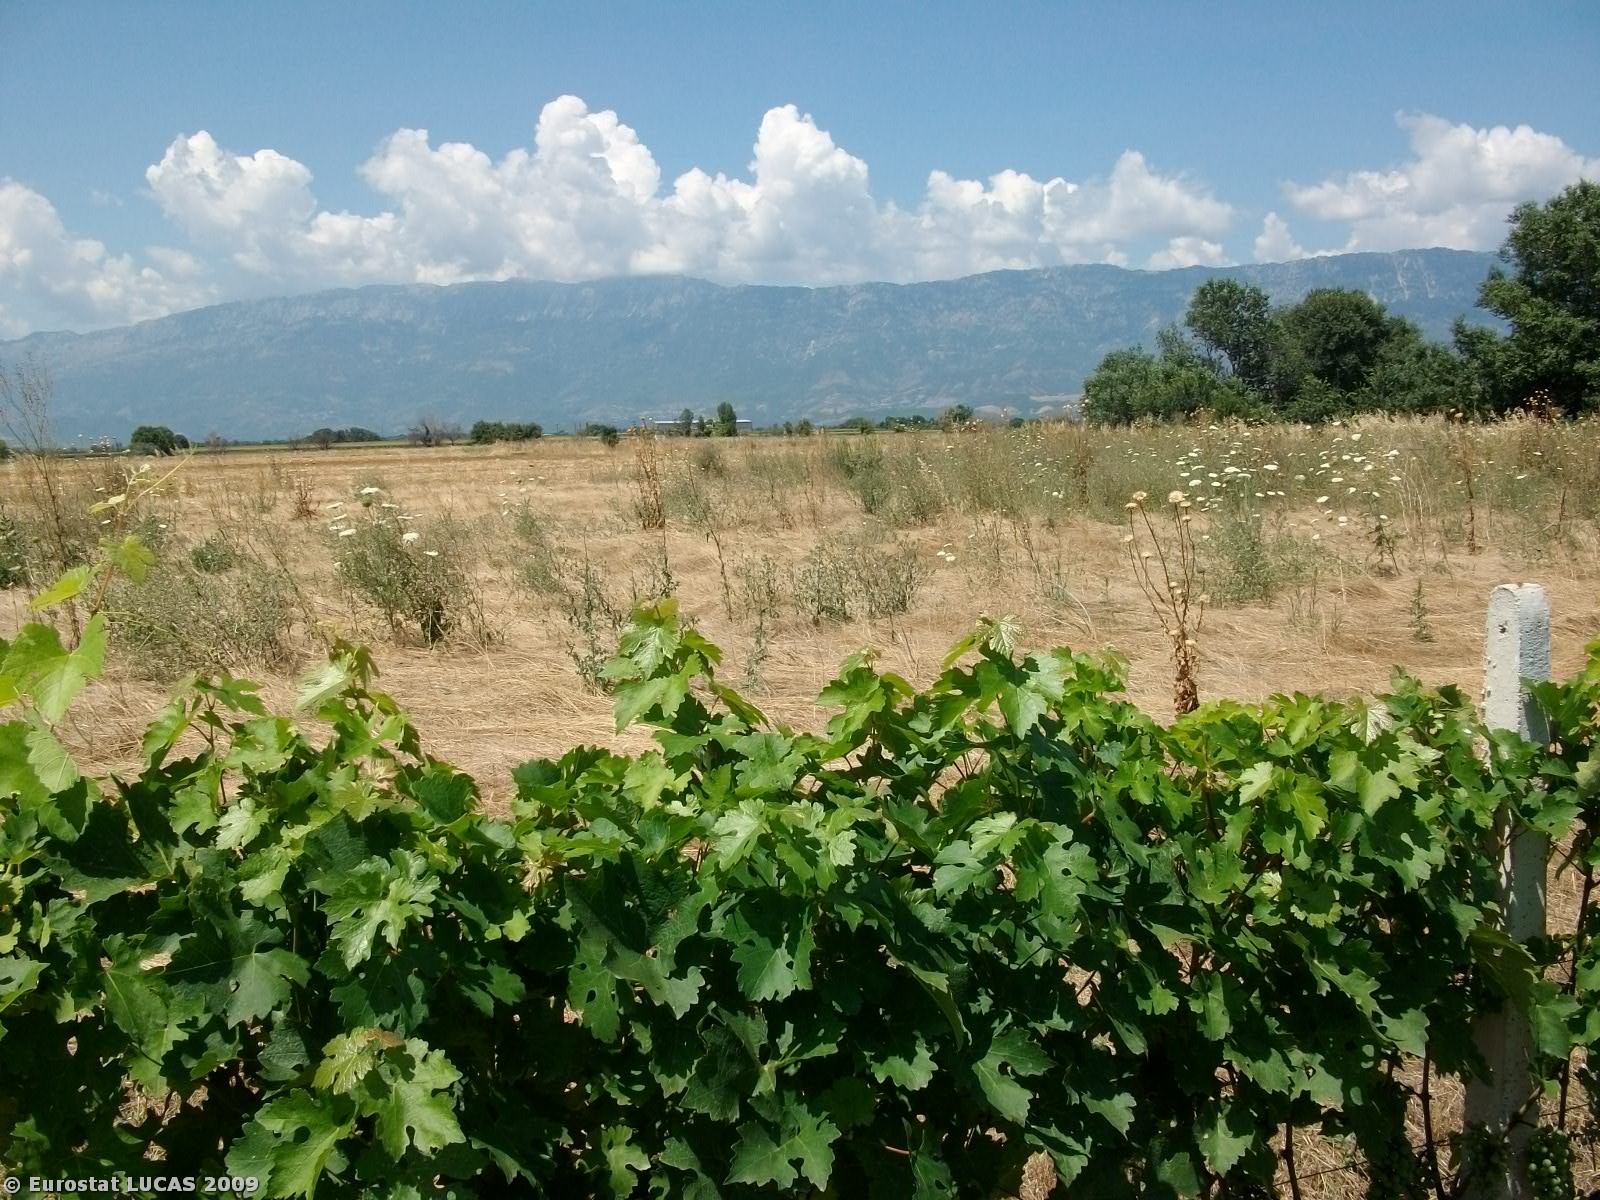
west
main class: Cropland
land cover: Vineyards
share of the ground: 25 - 50 %
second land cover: Grassland with sparse tree/shrub cover
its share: > 75 %
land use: Agriculture (excluding fallow land and kitchen gardens)
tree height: < 5 m
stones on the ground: < 10 %
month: July
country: GR
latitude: 39.6000
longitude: 21.7106
